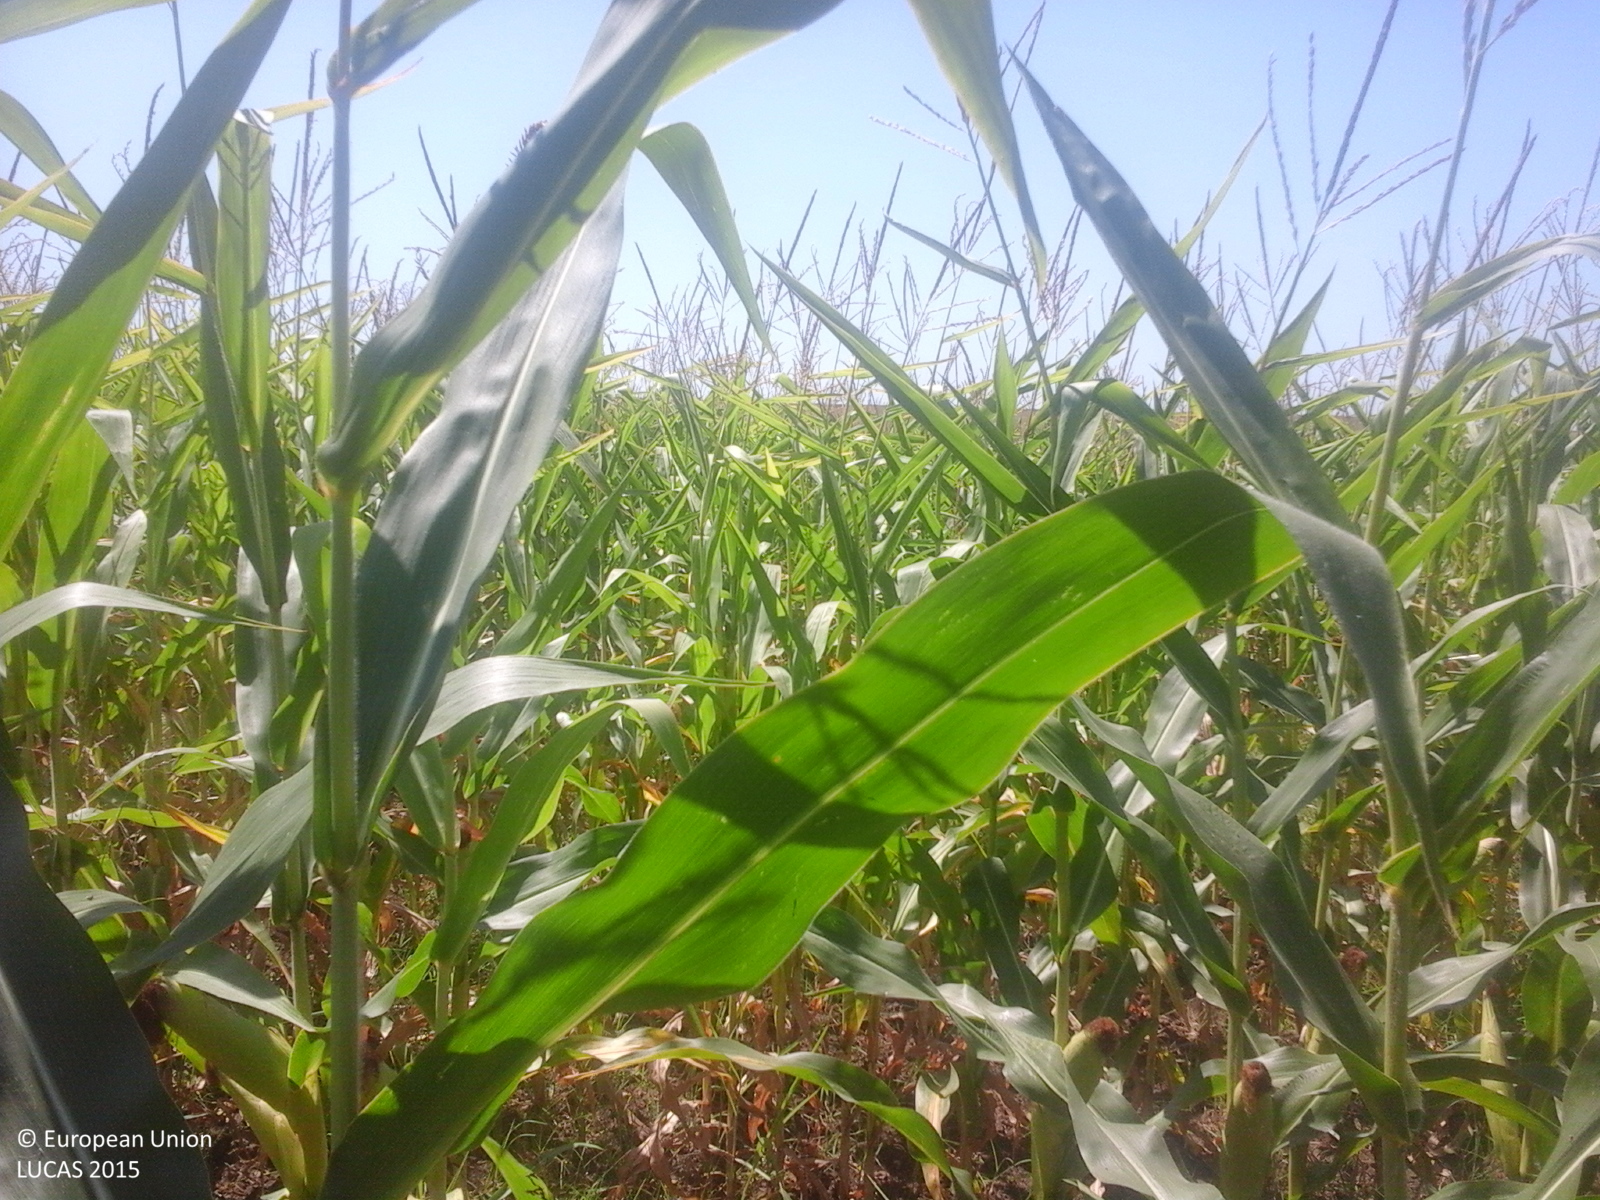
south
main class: Cropland
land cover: Maize
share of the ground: > 75 %
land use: Agriculture (excluding fallow land and kitchen gardens)
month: July
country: RO
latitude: 44.4124
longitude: 26.6322
